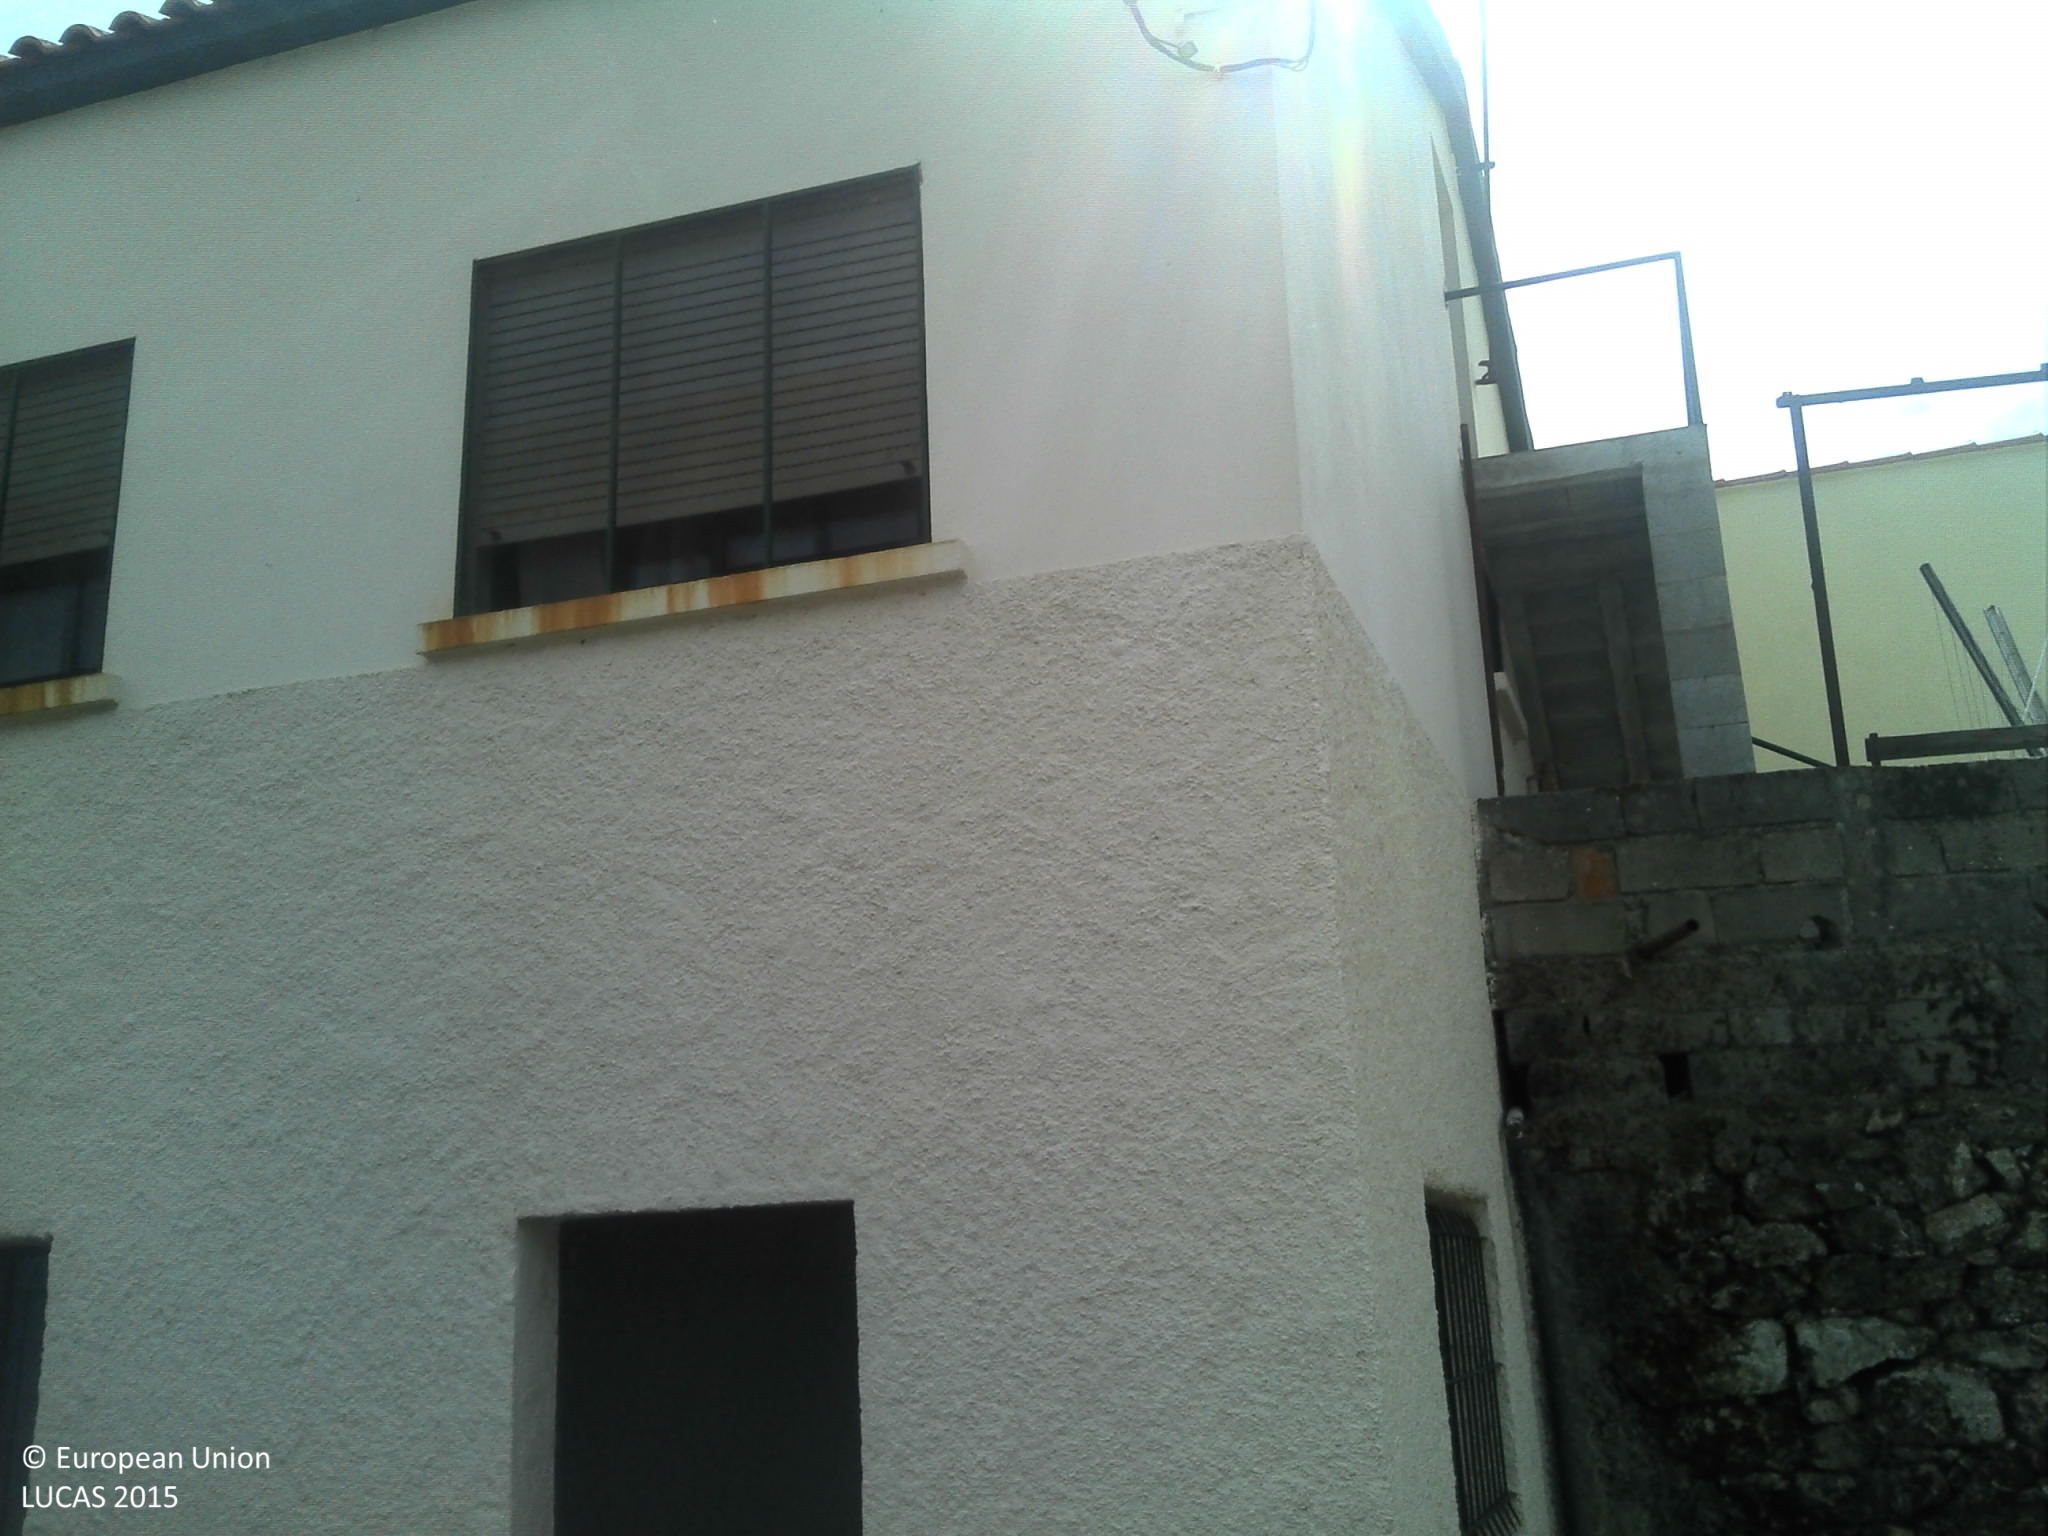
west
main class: Grassland
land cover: Grassland without tree/shrub cover
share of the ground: < 10 %
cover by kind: unconsolidated bare surface 90 %, herbaceous plants 10 %
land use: Agriculture (excluding fallow land and kitchen gardens)
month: June
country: PT
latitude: 40.2929
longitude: -7.3613
